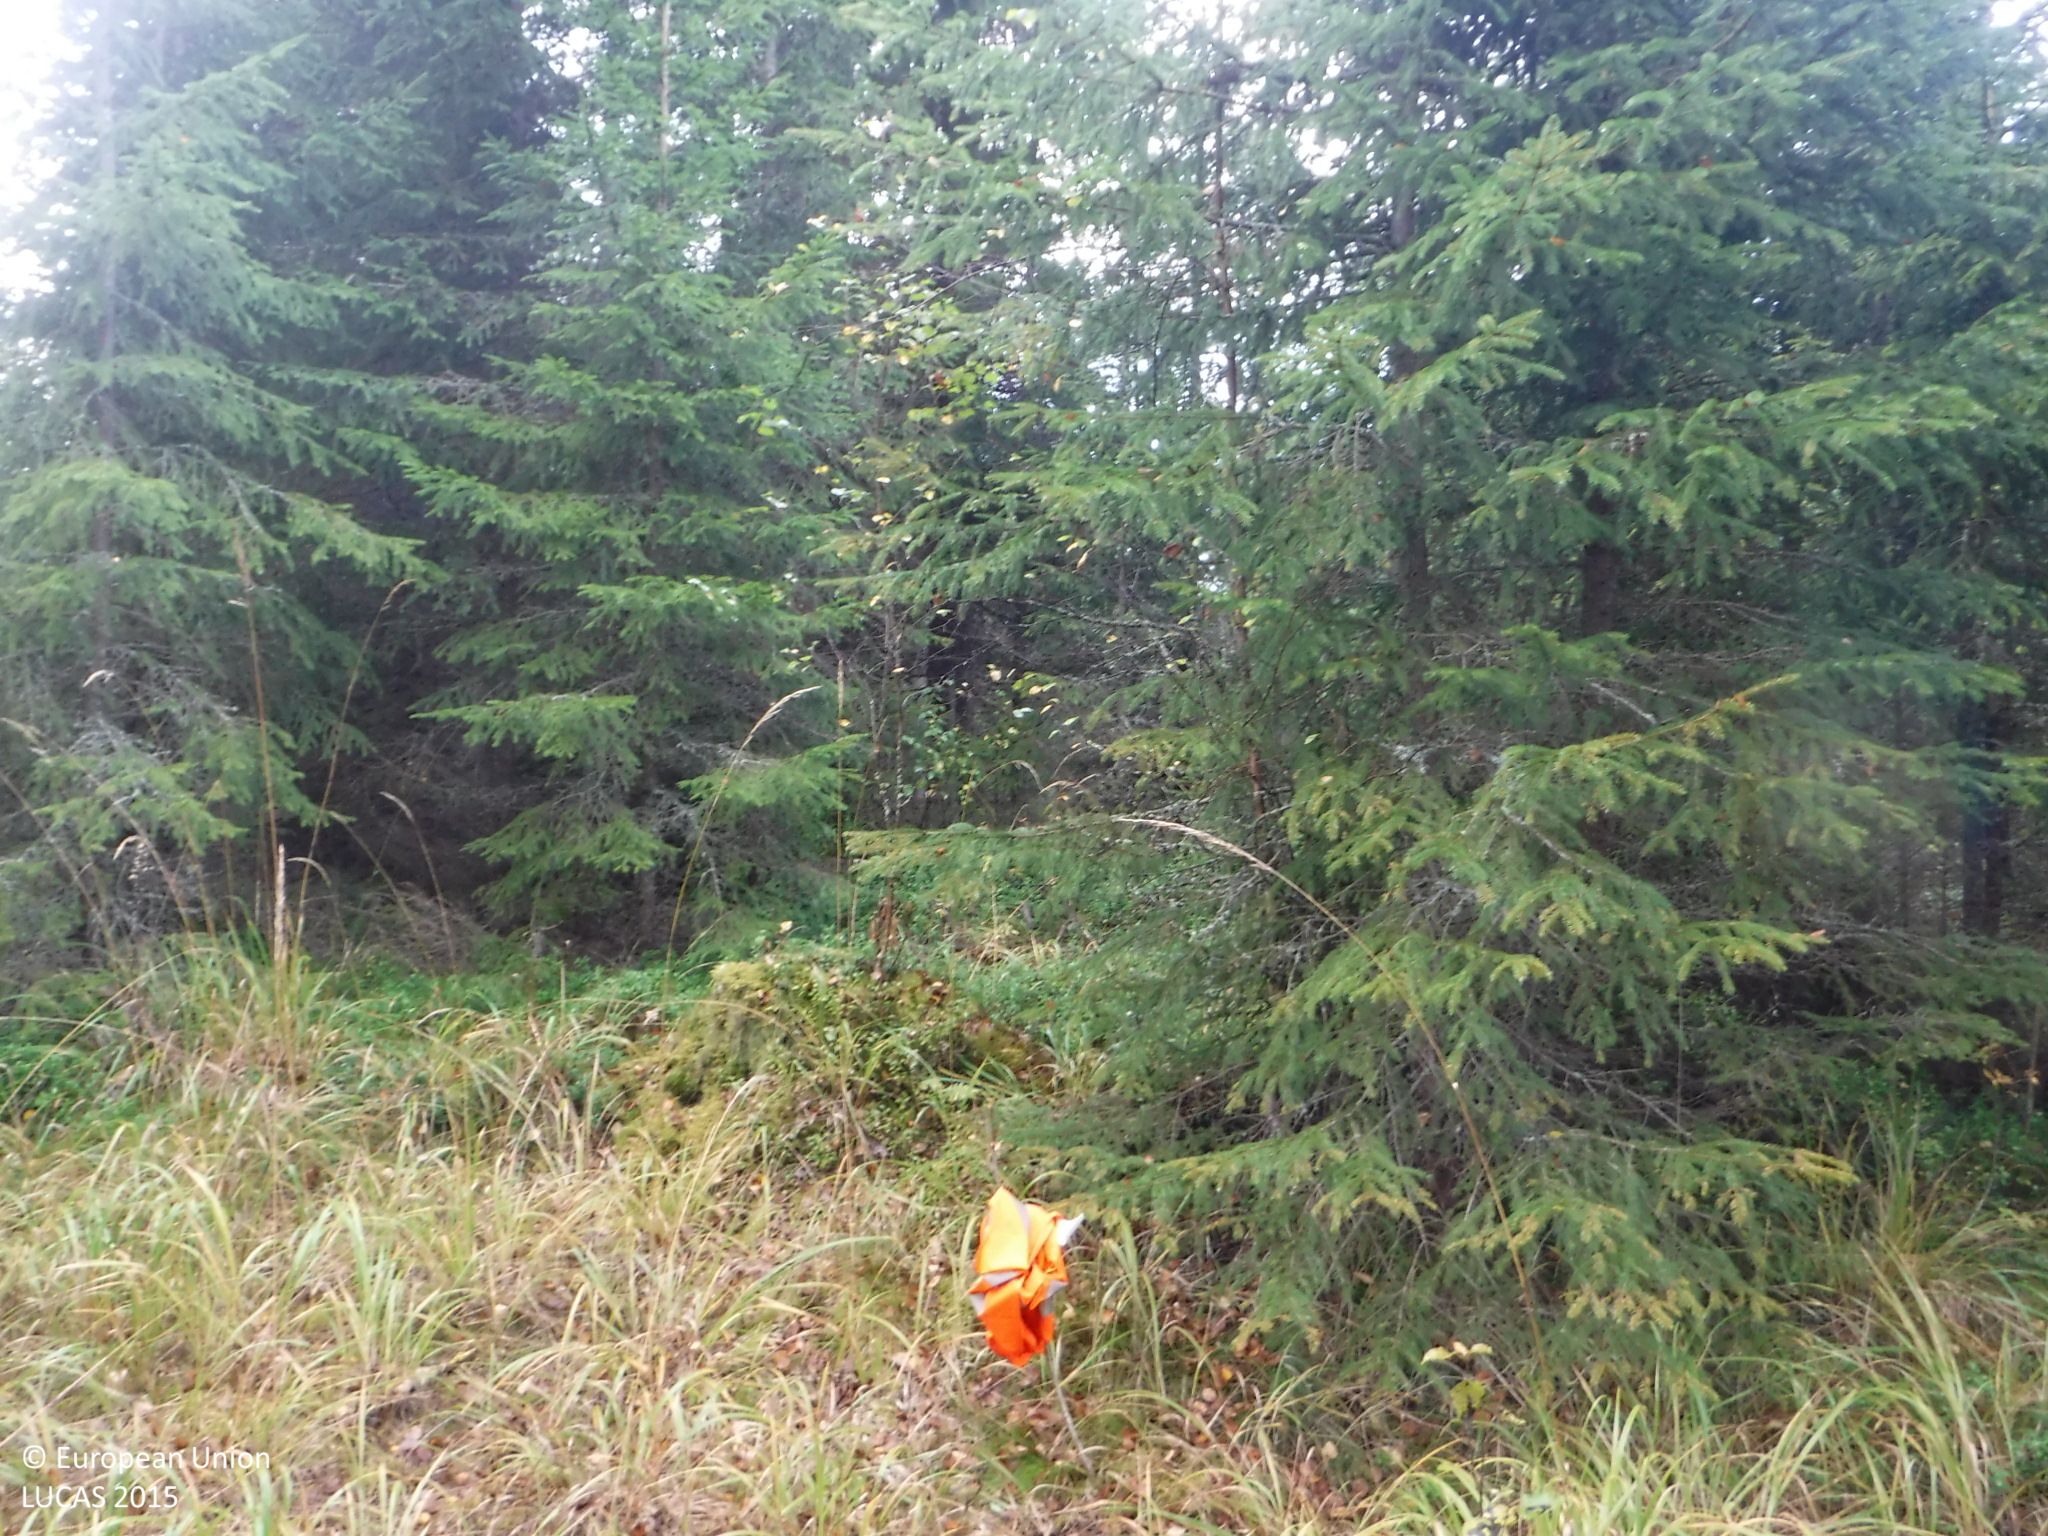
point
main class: Woodland
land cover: Spruce dominated coniferous woodland
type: boreal forest
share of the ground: 50 - 75 %
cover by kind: coniferous forest trees 55 %, herbaceous plants 40 %, lichens and mosses 5 %
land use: Forestry
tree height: > 5 m
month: September
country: FI
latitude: 61.7053
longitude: 24.1022
